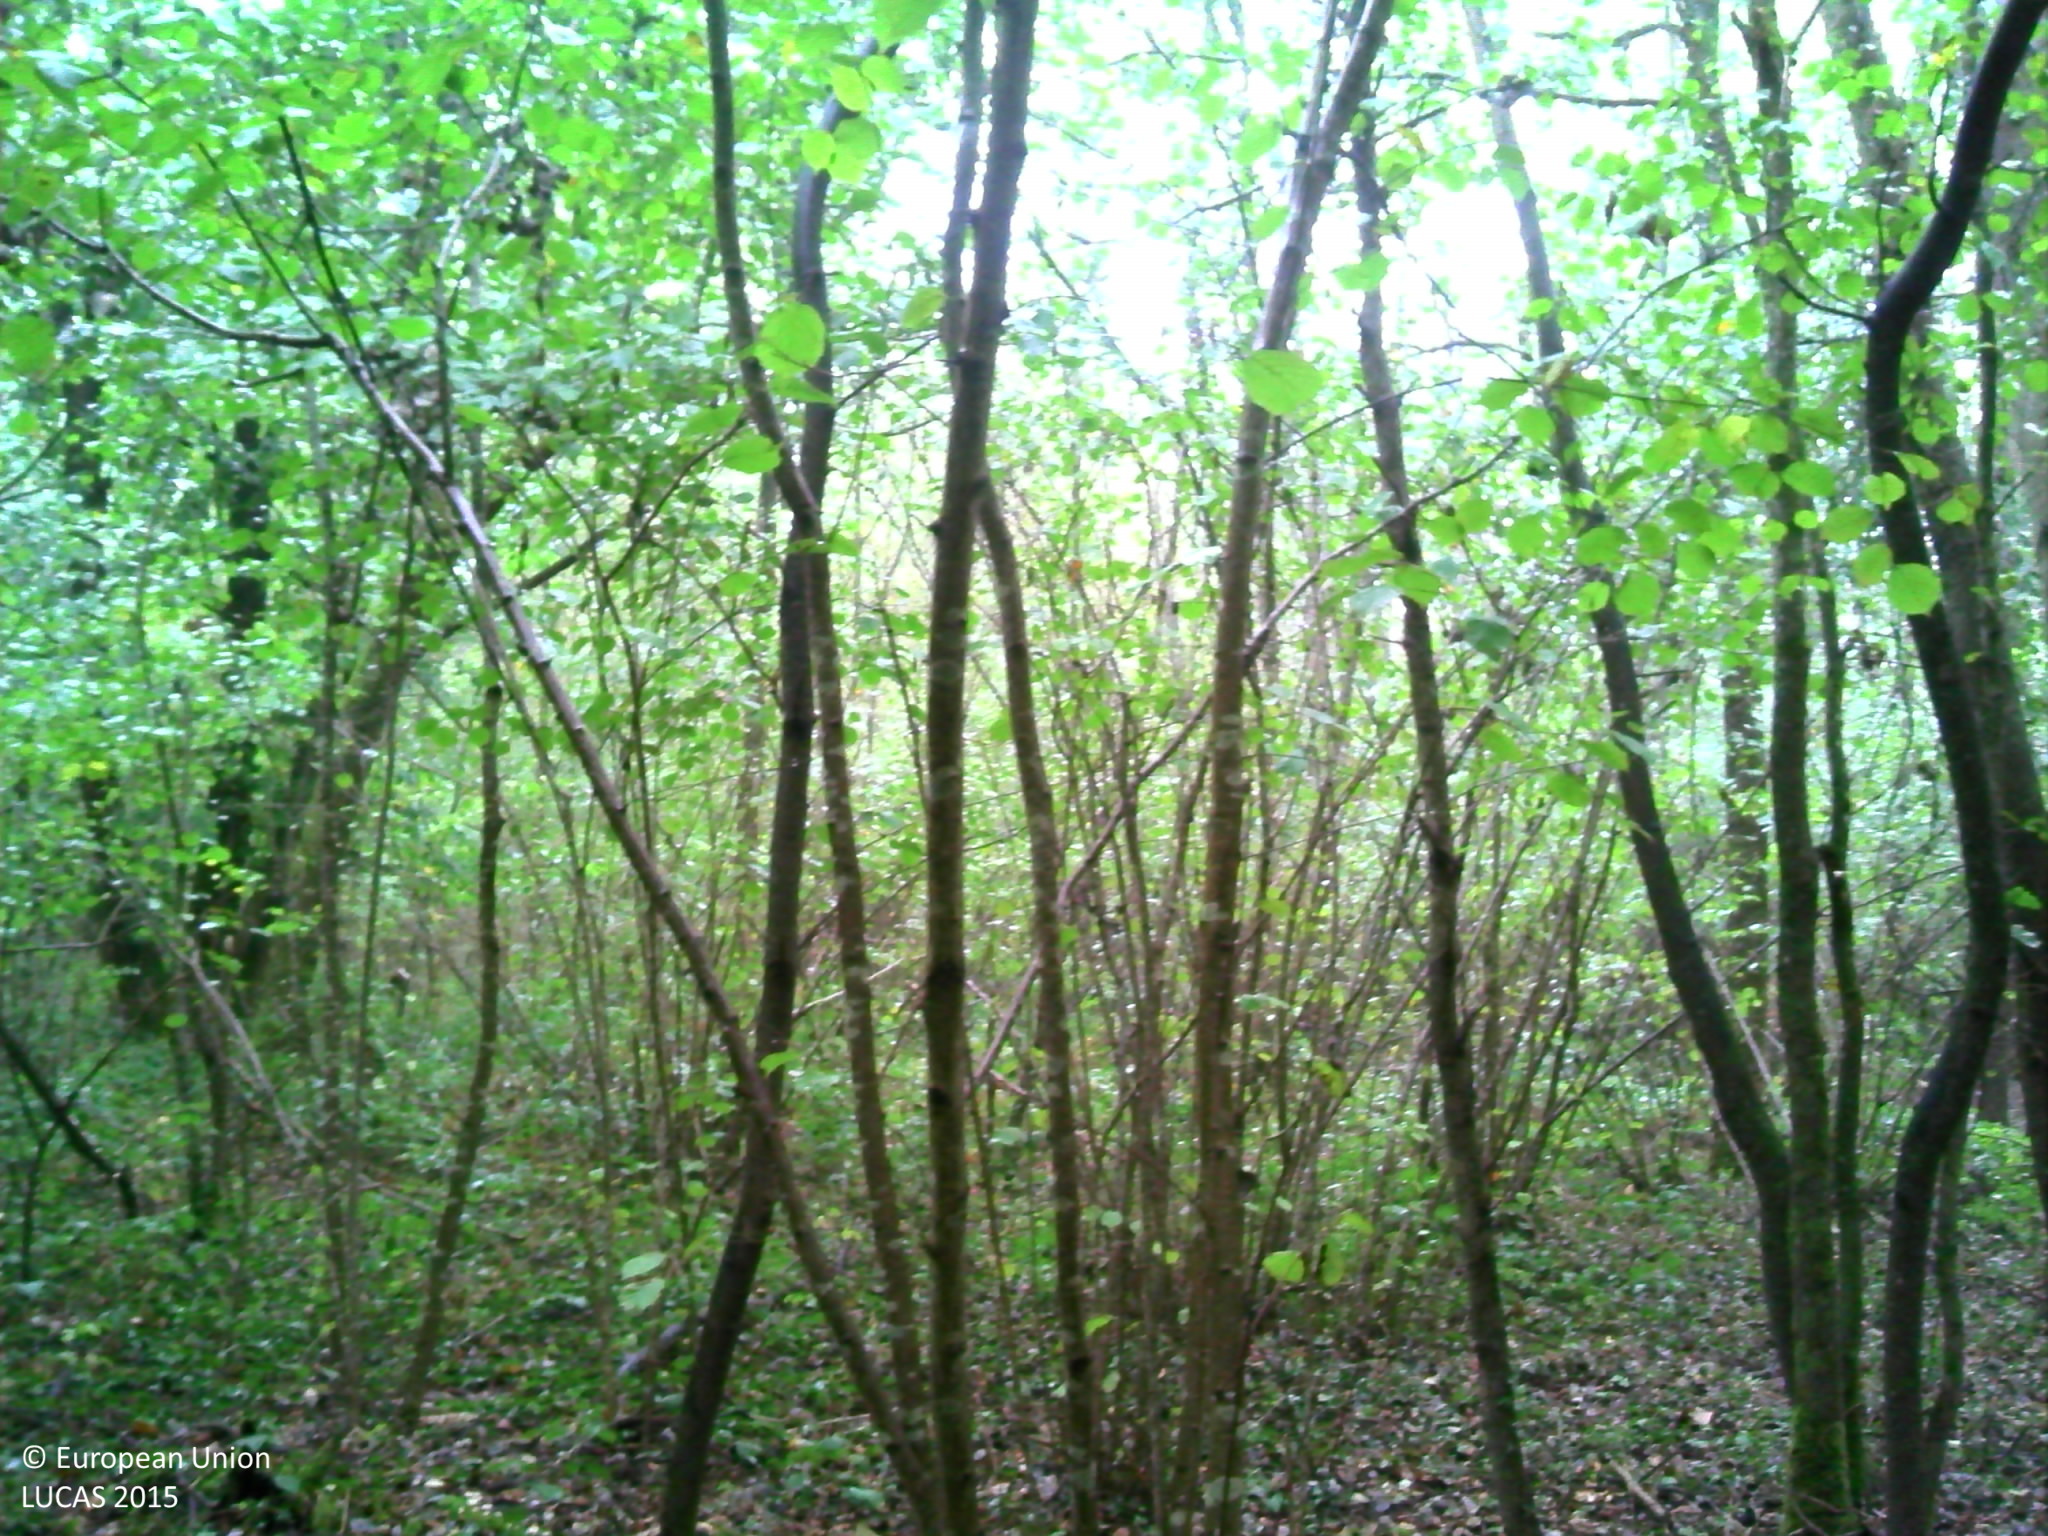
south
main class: Woodland
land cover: Broadleaved woodland
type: mesophytic deciduous forest
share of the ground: > 75 %
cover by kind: broadleaved forest trees 90 %, herbaceous plants 5 %, lichens and mosses 5 %
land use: Forestry
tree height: > 5 m
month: October
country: FR
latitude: 46.4204
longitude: 5.1232
